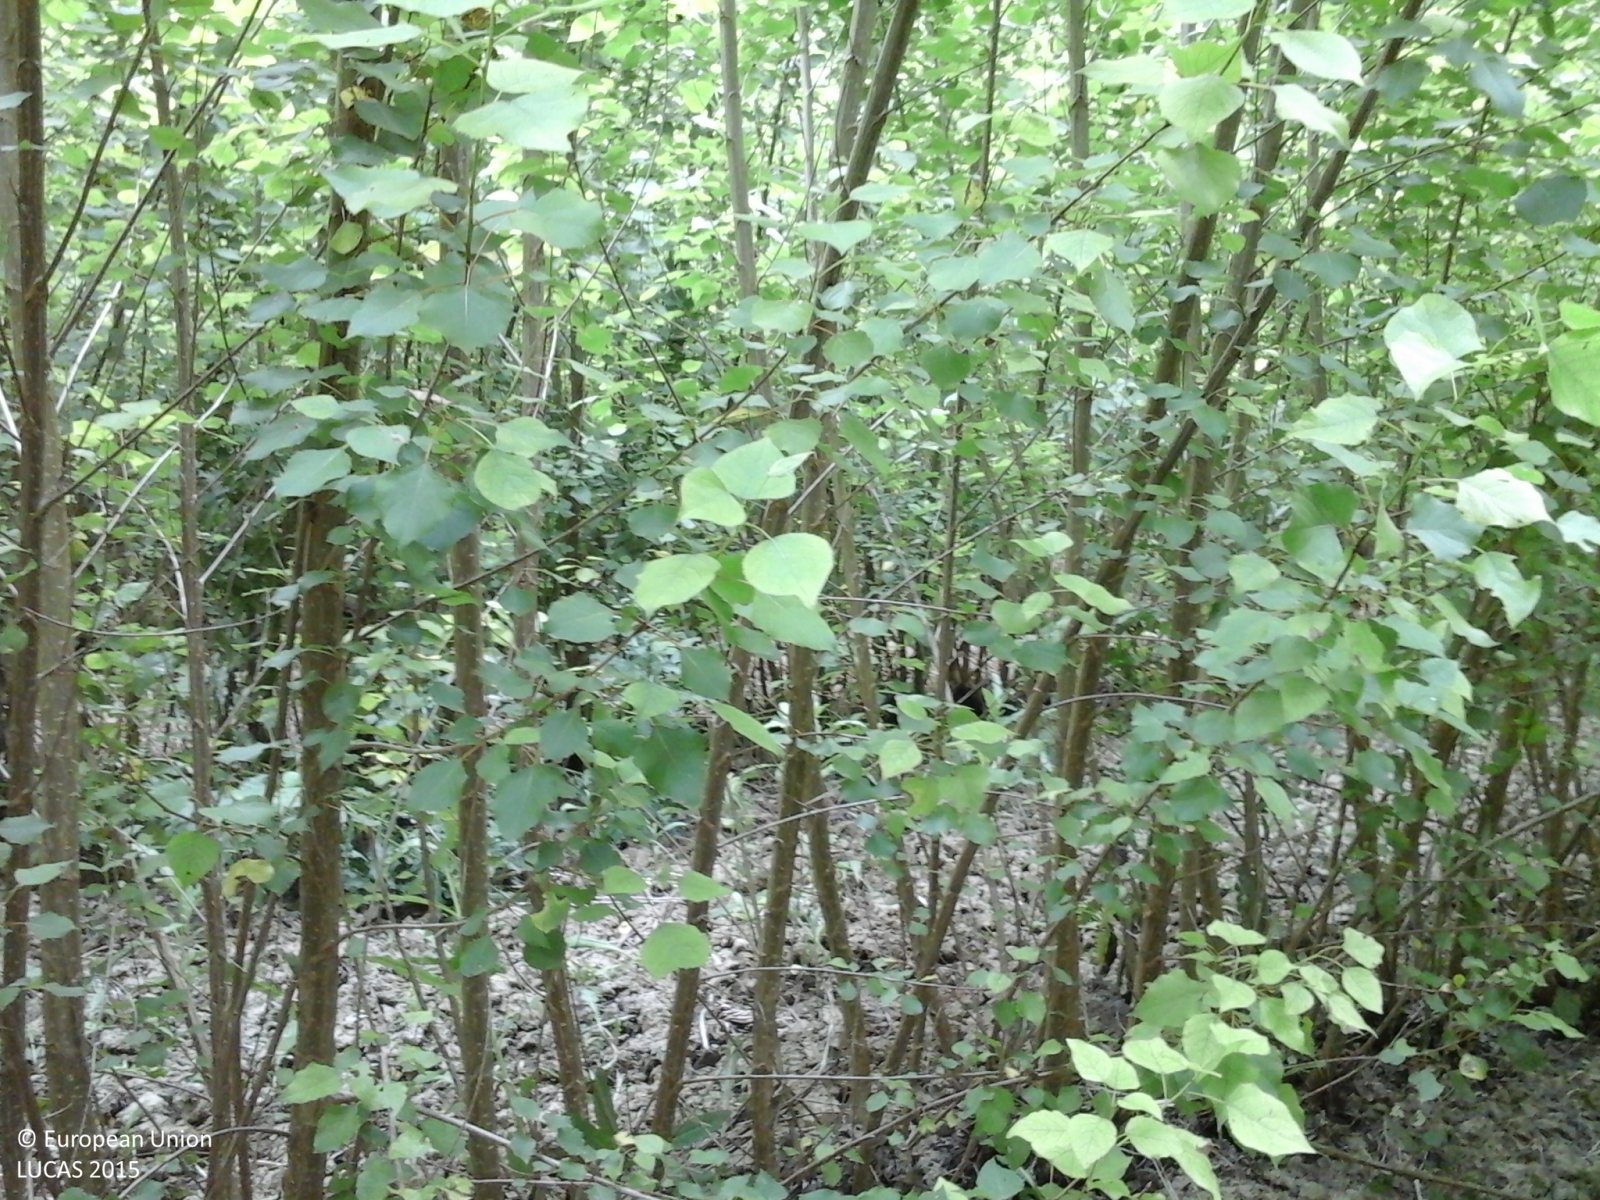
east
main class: Woodland
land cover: Broadleaved woodland
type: non-riverine alder, birch or aspen forest
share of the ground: > 75 %
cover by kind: broadleaved forest trees 100 %
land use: Forestry
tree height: < 5 m
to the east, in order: Broadleaved woodland; Other bare soil; Grassland without tree/shrub cover; Electric lines; Grass margins; Ditches and canals; Tracks; Grass margins; Inland fresh running water; Grassland without tree/shrub cover; Soya; Grassland without tree/shrub cover; Inland fresh running water; Grass margins; Tracks; Grass margins; Ditches and canals; Electric lines; Grass margins; Maize
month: June
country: IT
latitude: 44.8021
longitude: 11.9053
